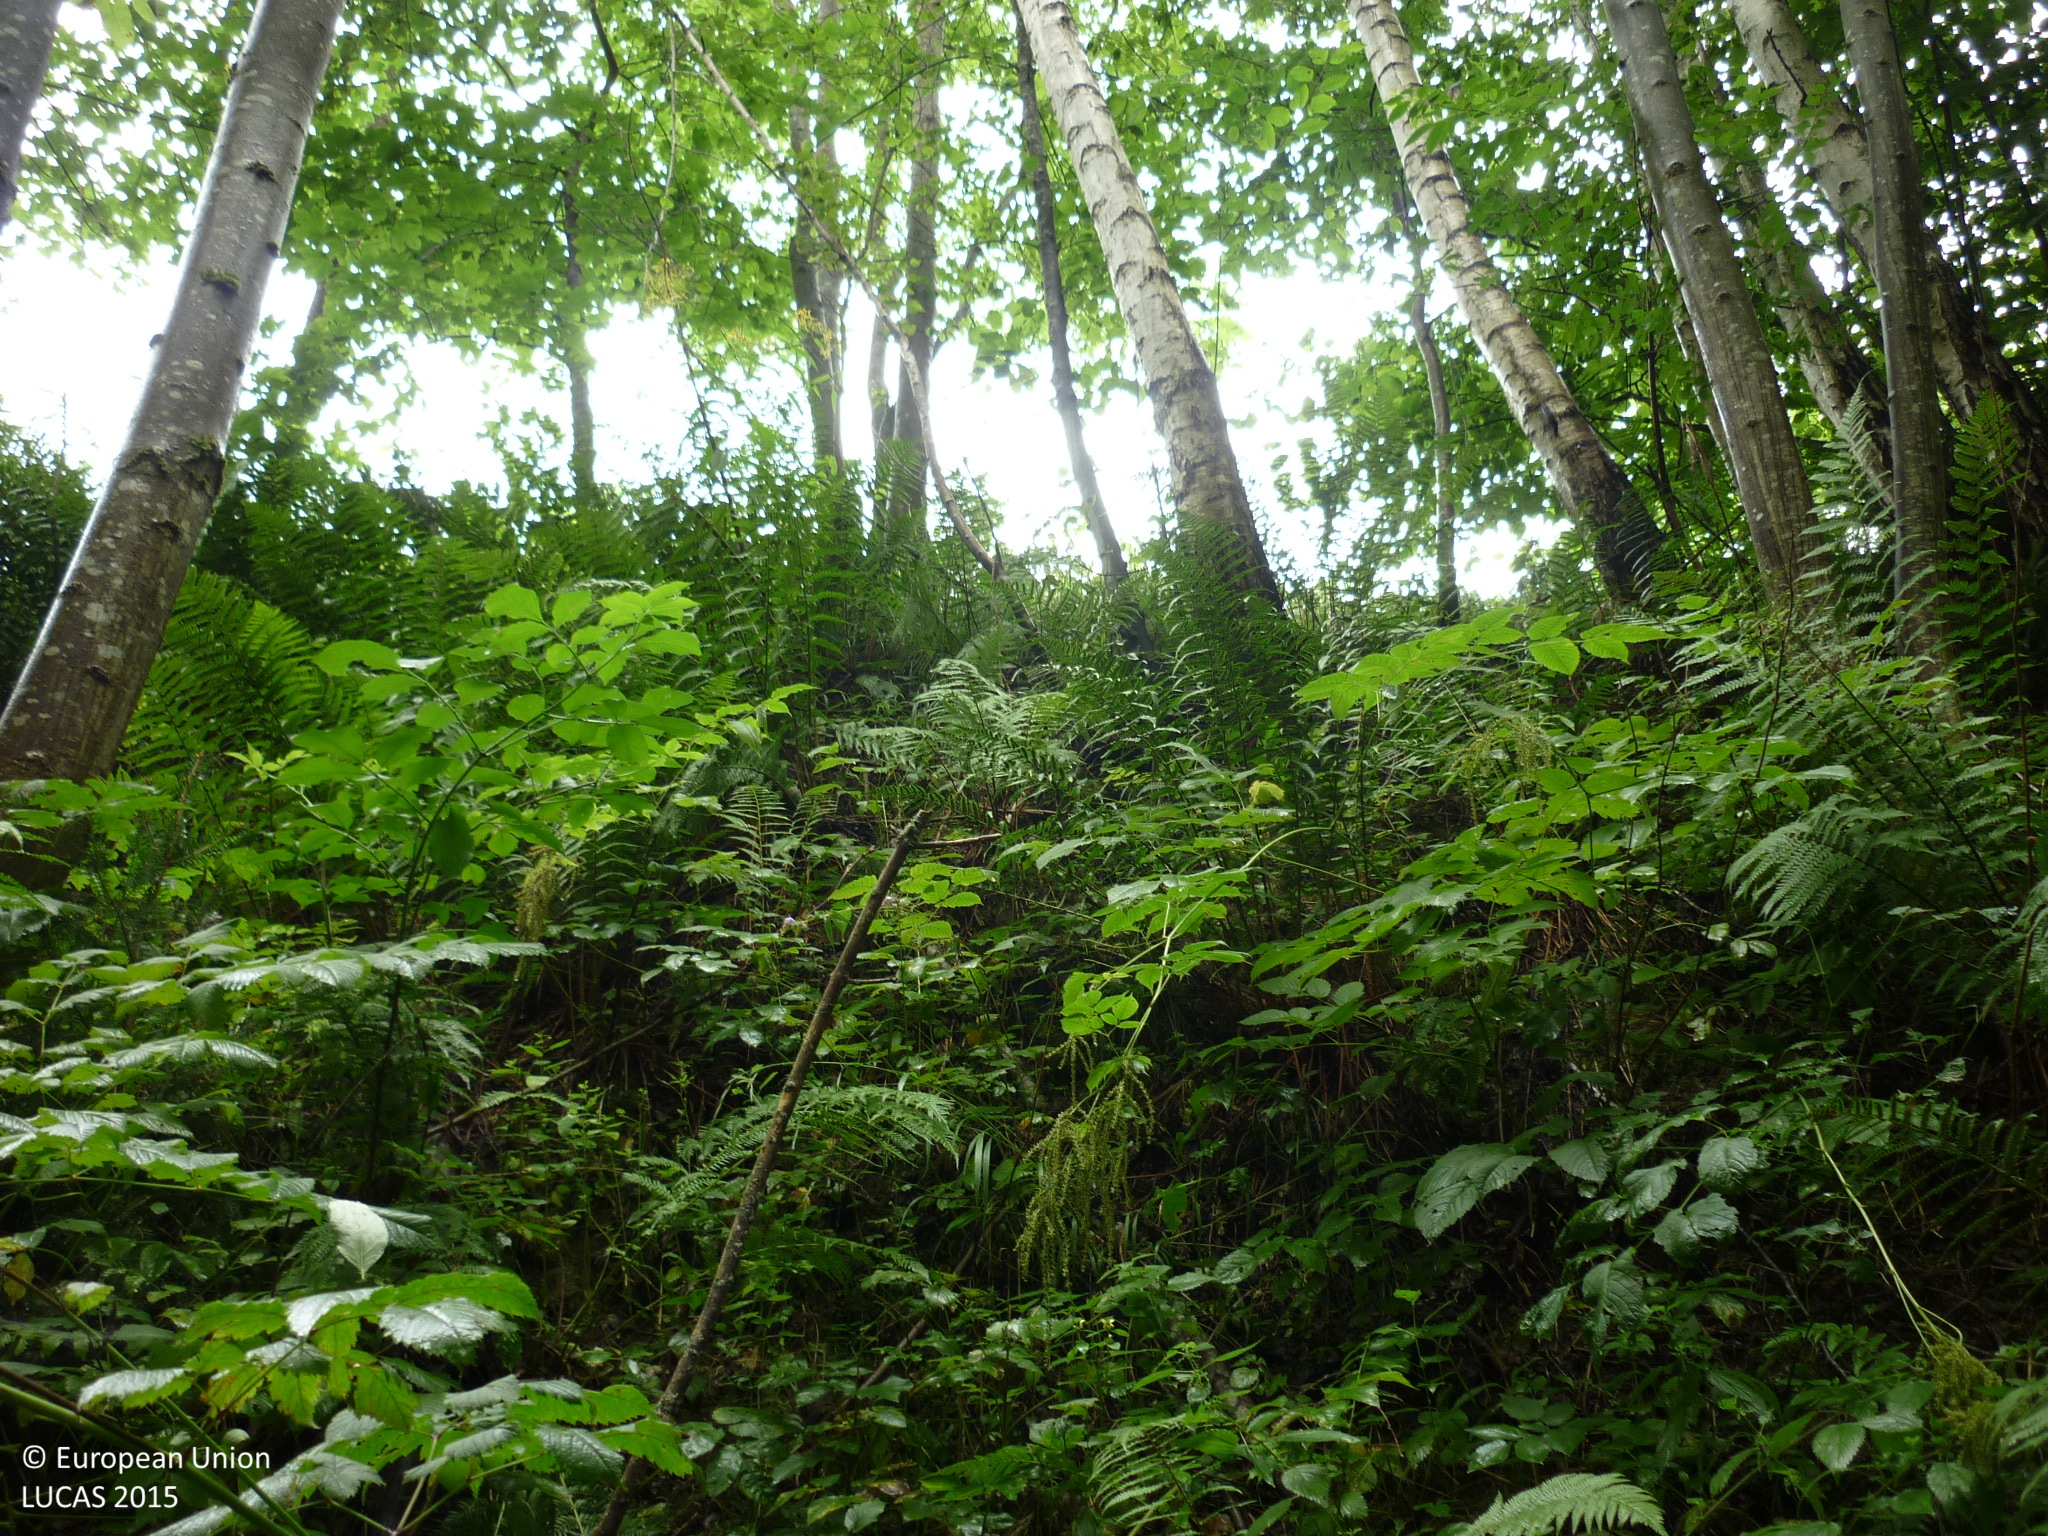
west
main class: Woodland
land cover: Broadleaved woodland
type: floodplain forest
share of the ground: > 75 %
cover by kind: broadleaved forest trees 70 %, shrubs 15 %, herbaceous plants 15 %
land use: Semi-natural and natural areas not in use
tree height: > 5 m
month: August
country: AT
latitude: 46.8536
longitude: 13.4731
